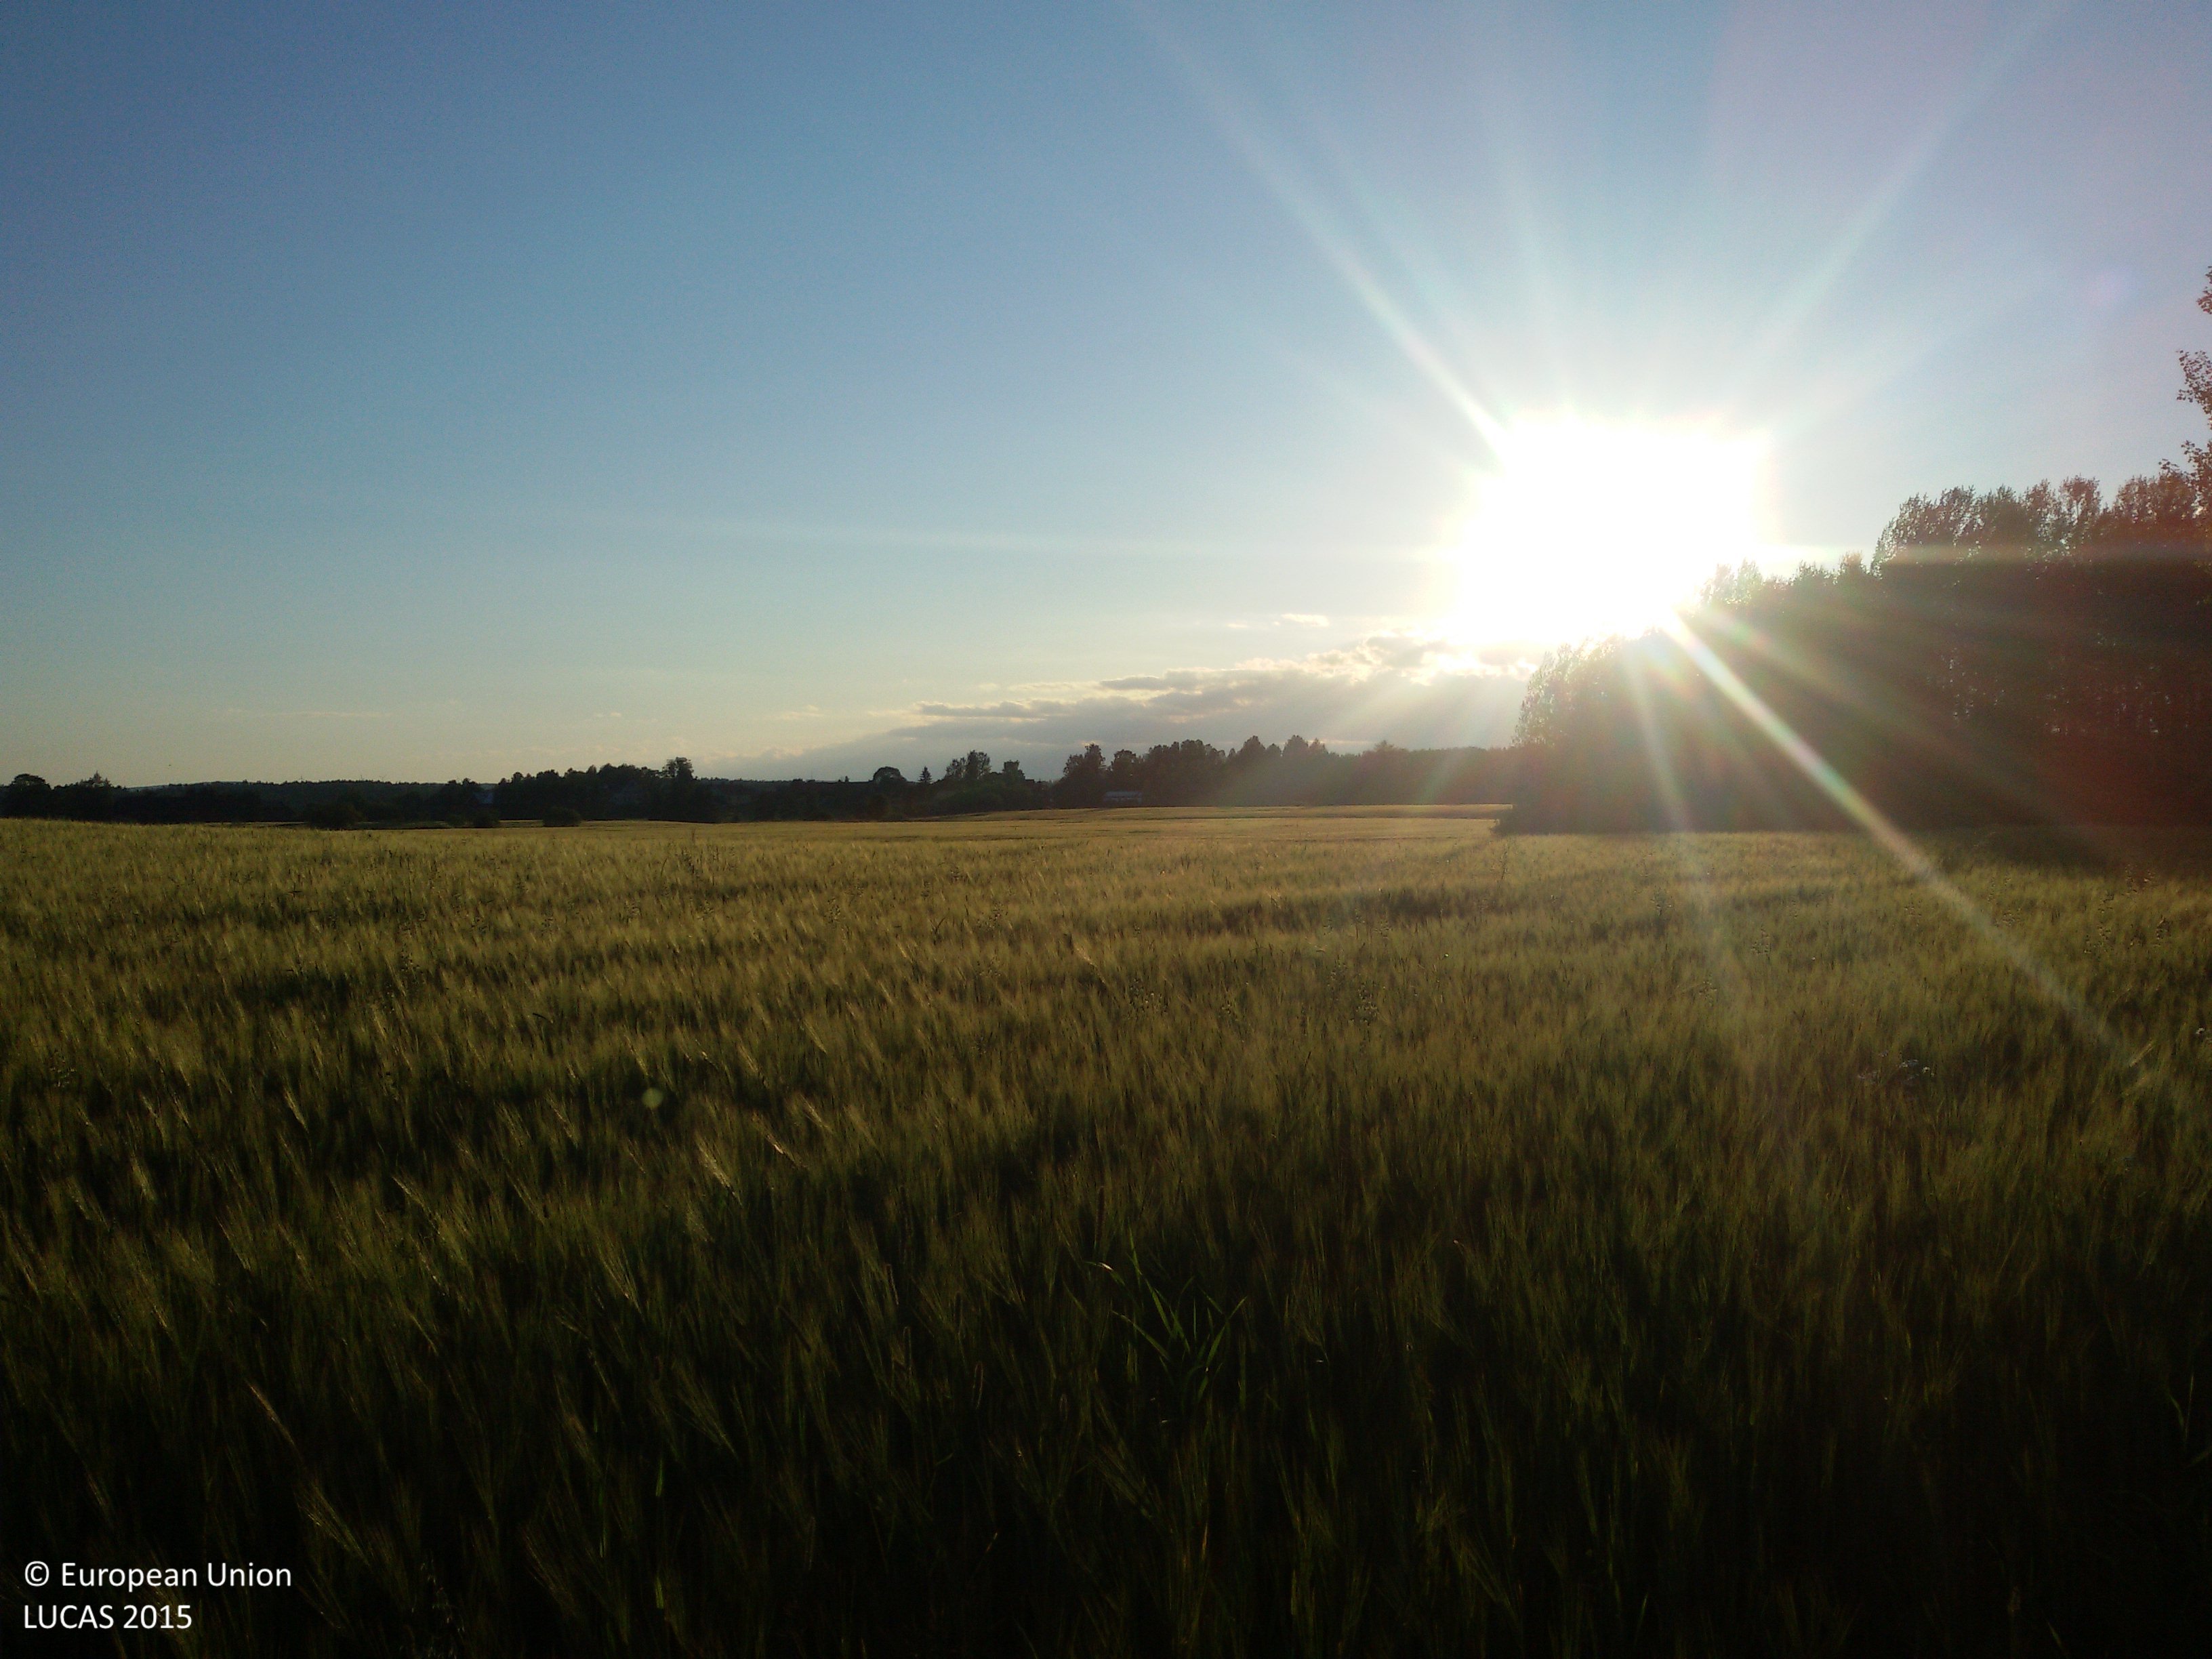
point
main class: Cropland
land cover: Barley
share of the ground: > 75 %
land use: Agriculture (excluding fallow land and kitchen gardens)
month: August
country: SE
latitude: 60.6216
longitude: 16.6217
